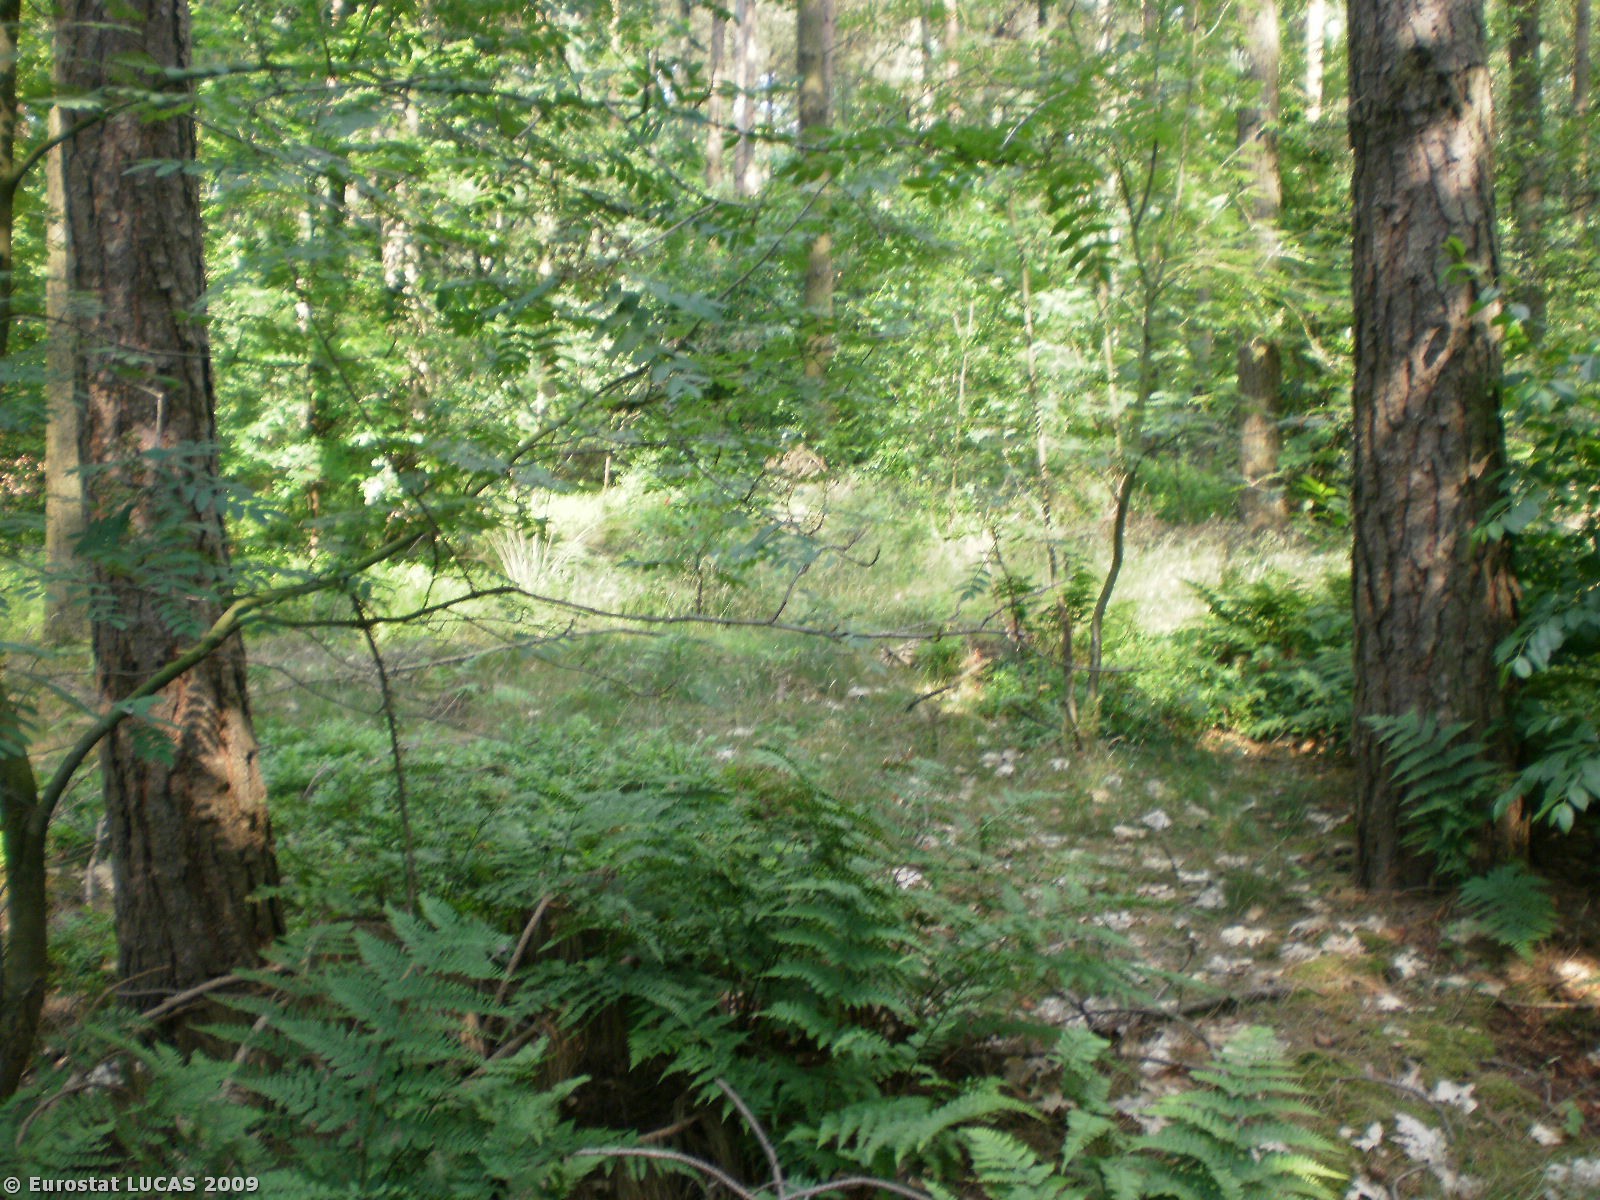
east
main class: Woodland
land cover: Mixed woodland
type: hemiboreal forest and nemoral coniferous forest and mixed broadleaved-coniferous forest
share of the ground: > 75 %
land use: Nature reserves
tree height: > 5 m
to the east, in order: Mixed woodland; Tracks; Mixed woodland
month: June
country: BE
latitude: 51.0299
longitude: 5.4495
